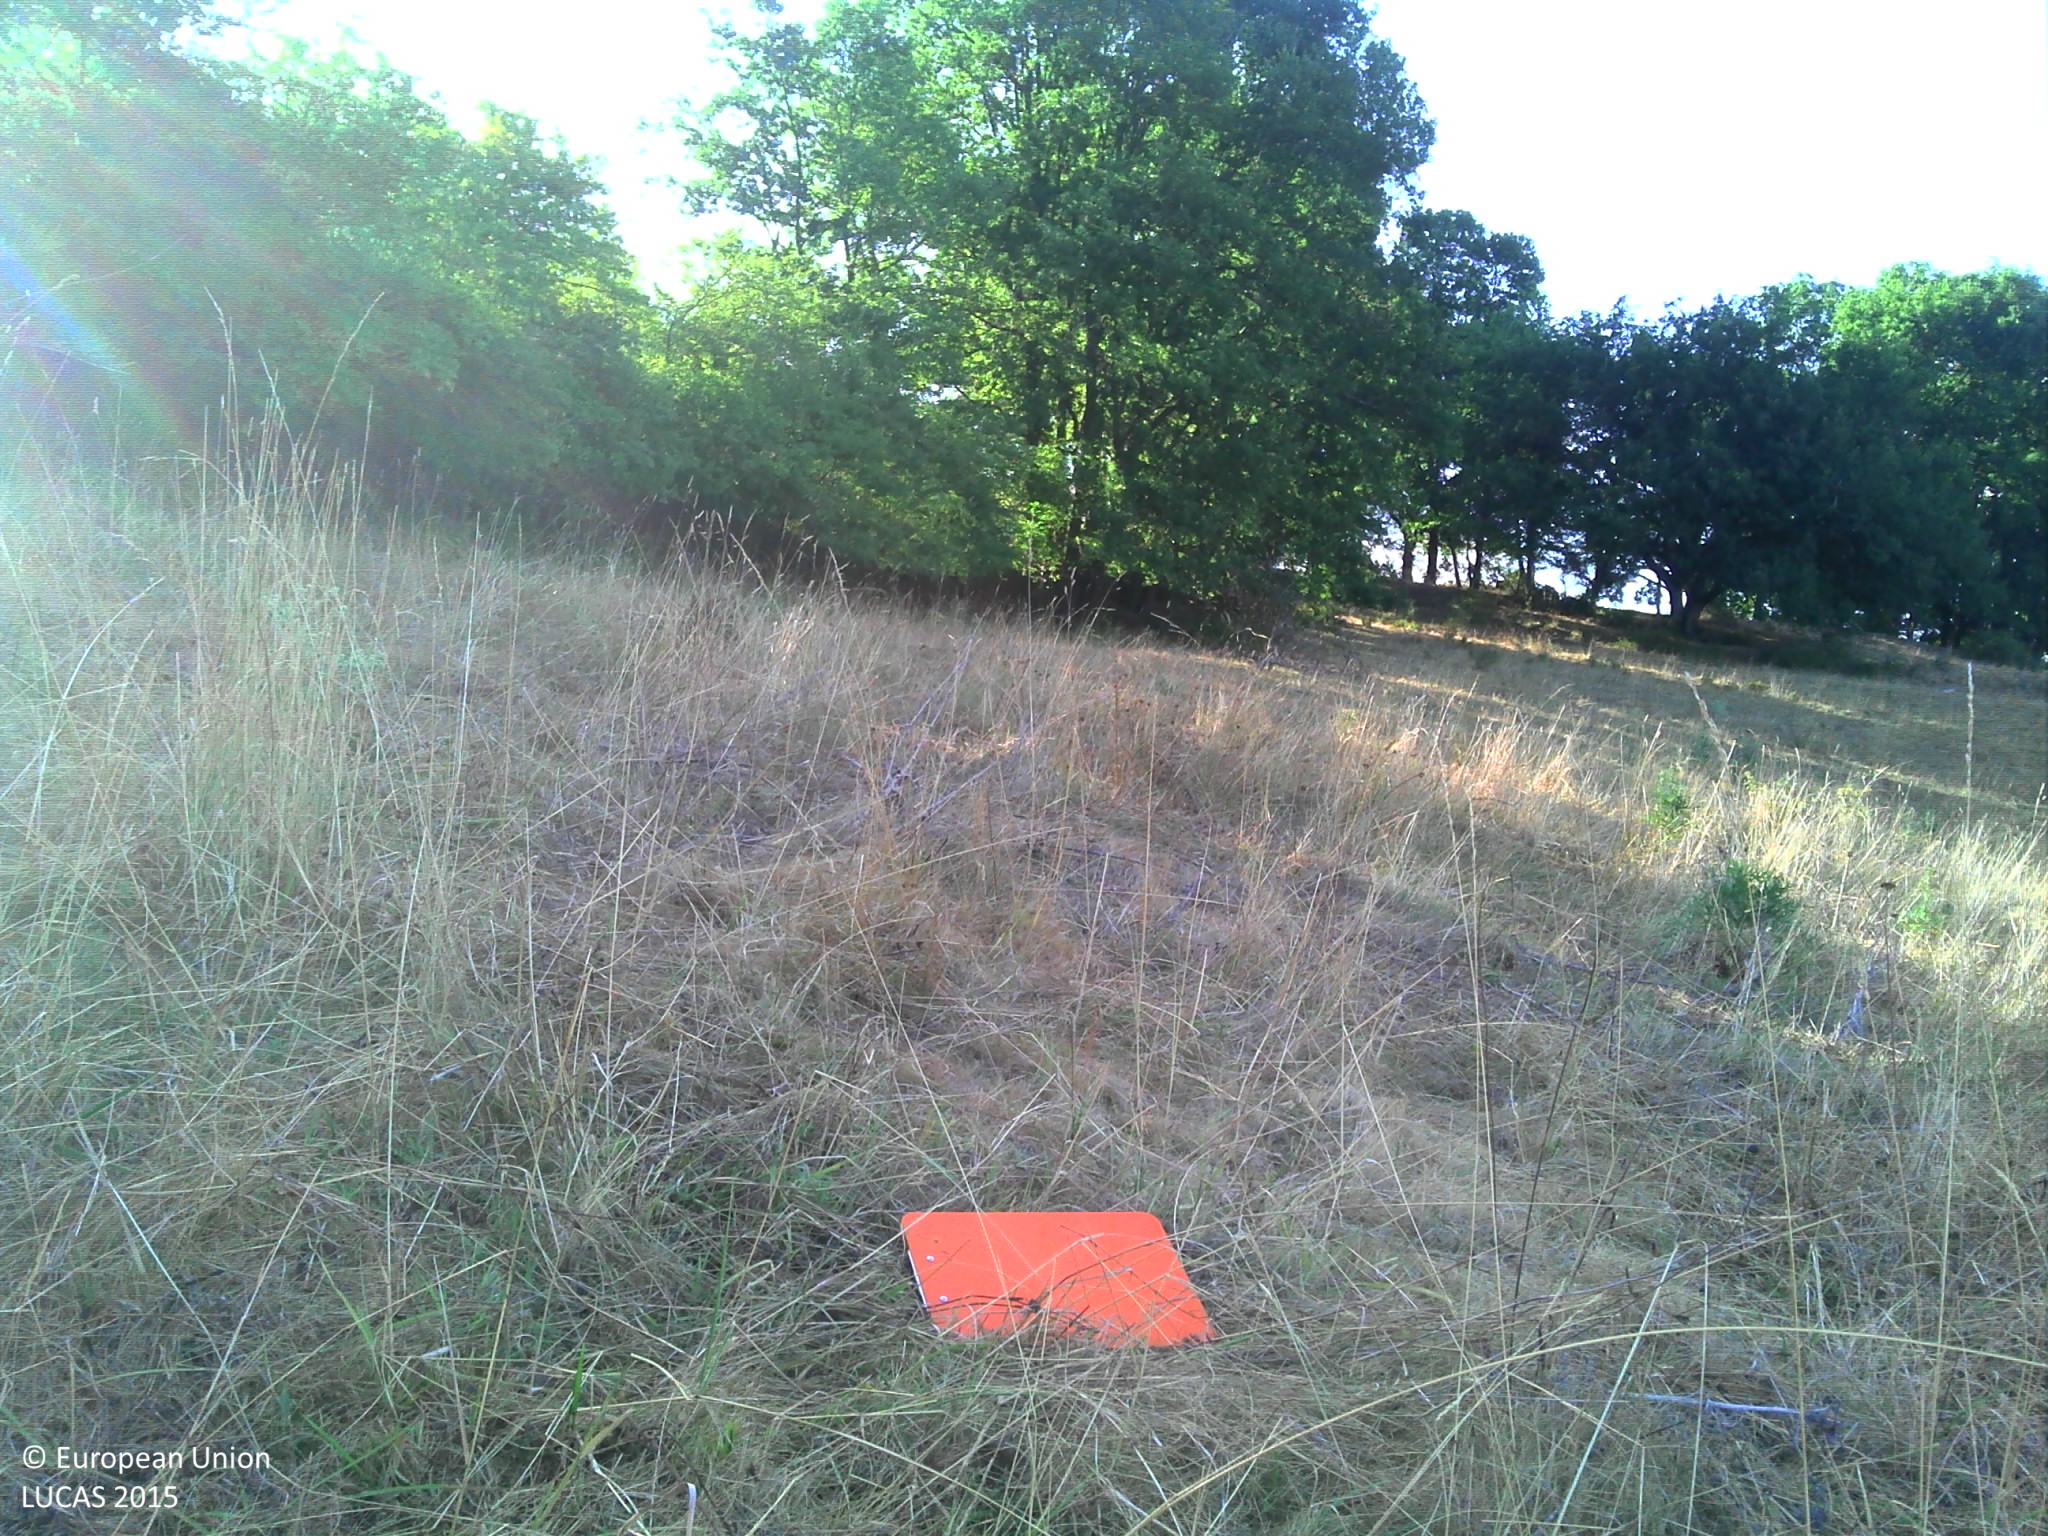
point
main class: Grassland
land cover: Grassland without tree/shrub cover
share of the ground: > 75 %
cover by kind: herbaceous plants 95 %, shrubs 5 %
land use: Agriculture (excluding fallow land and kitchen gardens)
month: July
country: FR
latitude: 44.3381
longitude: 0.5743
